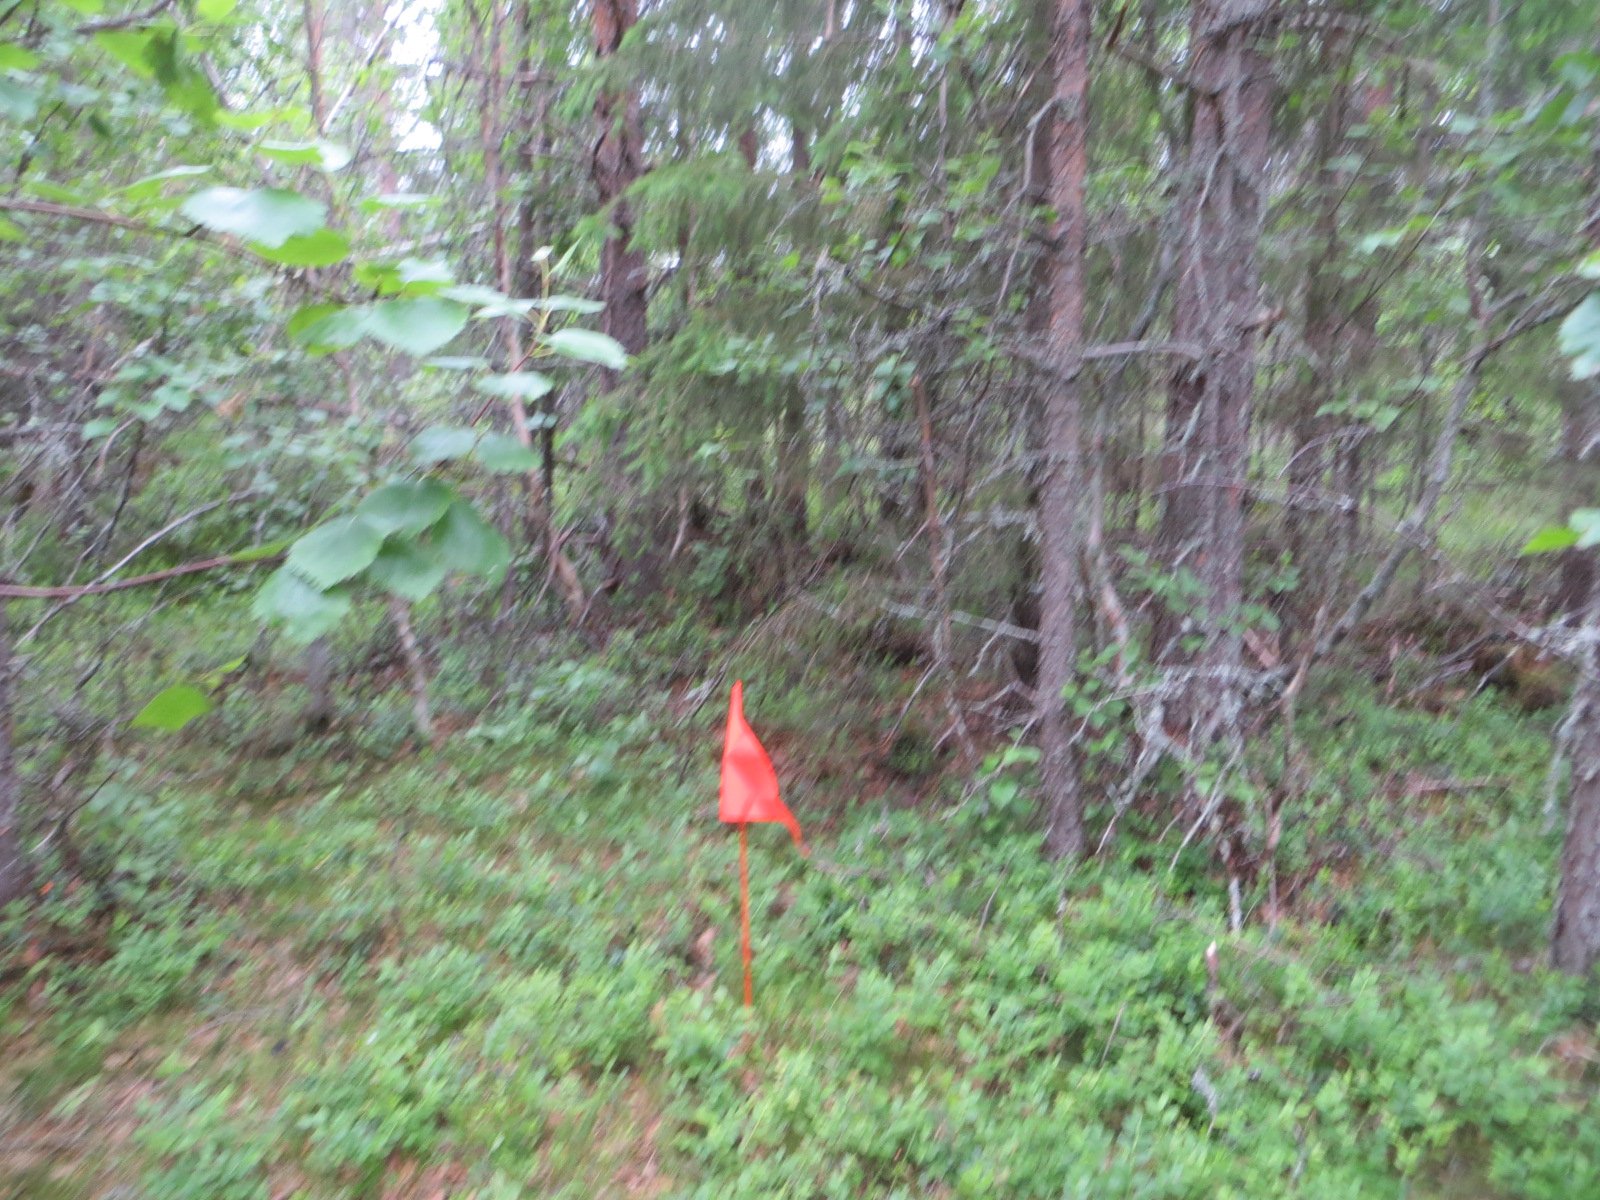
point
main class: Woodland
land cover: Other mixed woodland
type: boreal forest
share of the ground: > 75 %
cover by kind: coniferous forest trees 50 %, broadleaved forest trees 25 %, shrubs 25 %
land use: Forestry
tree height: > 5 m
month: July
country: FI
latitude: 65.7418
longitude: 25.2732
